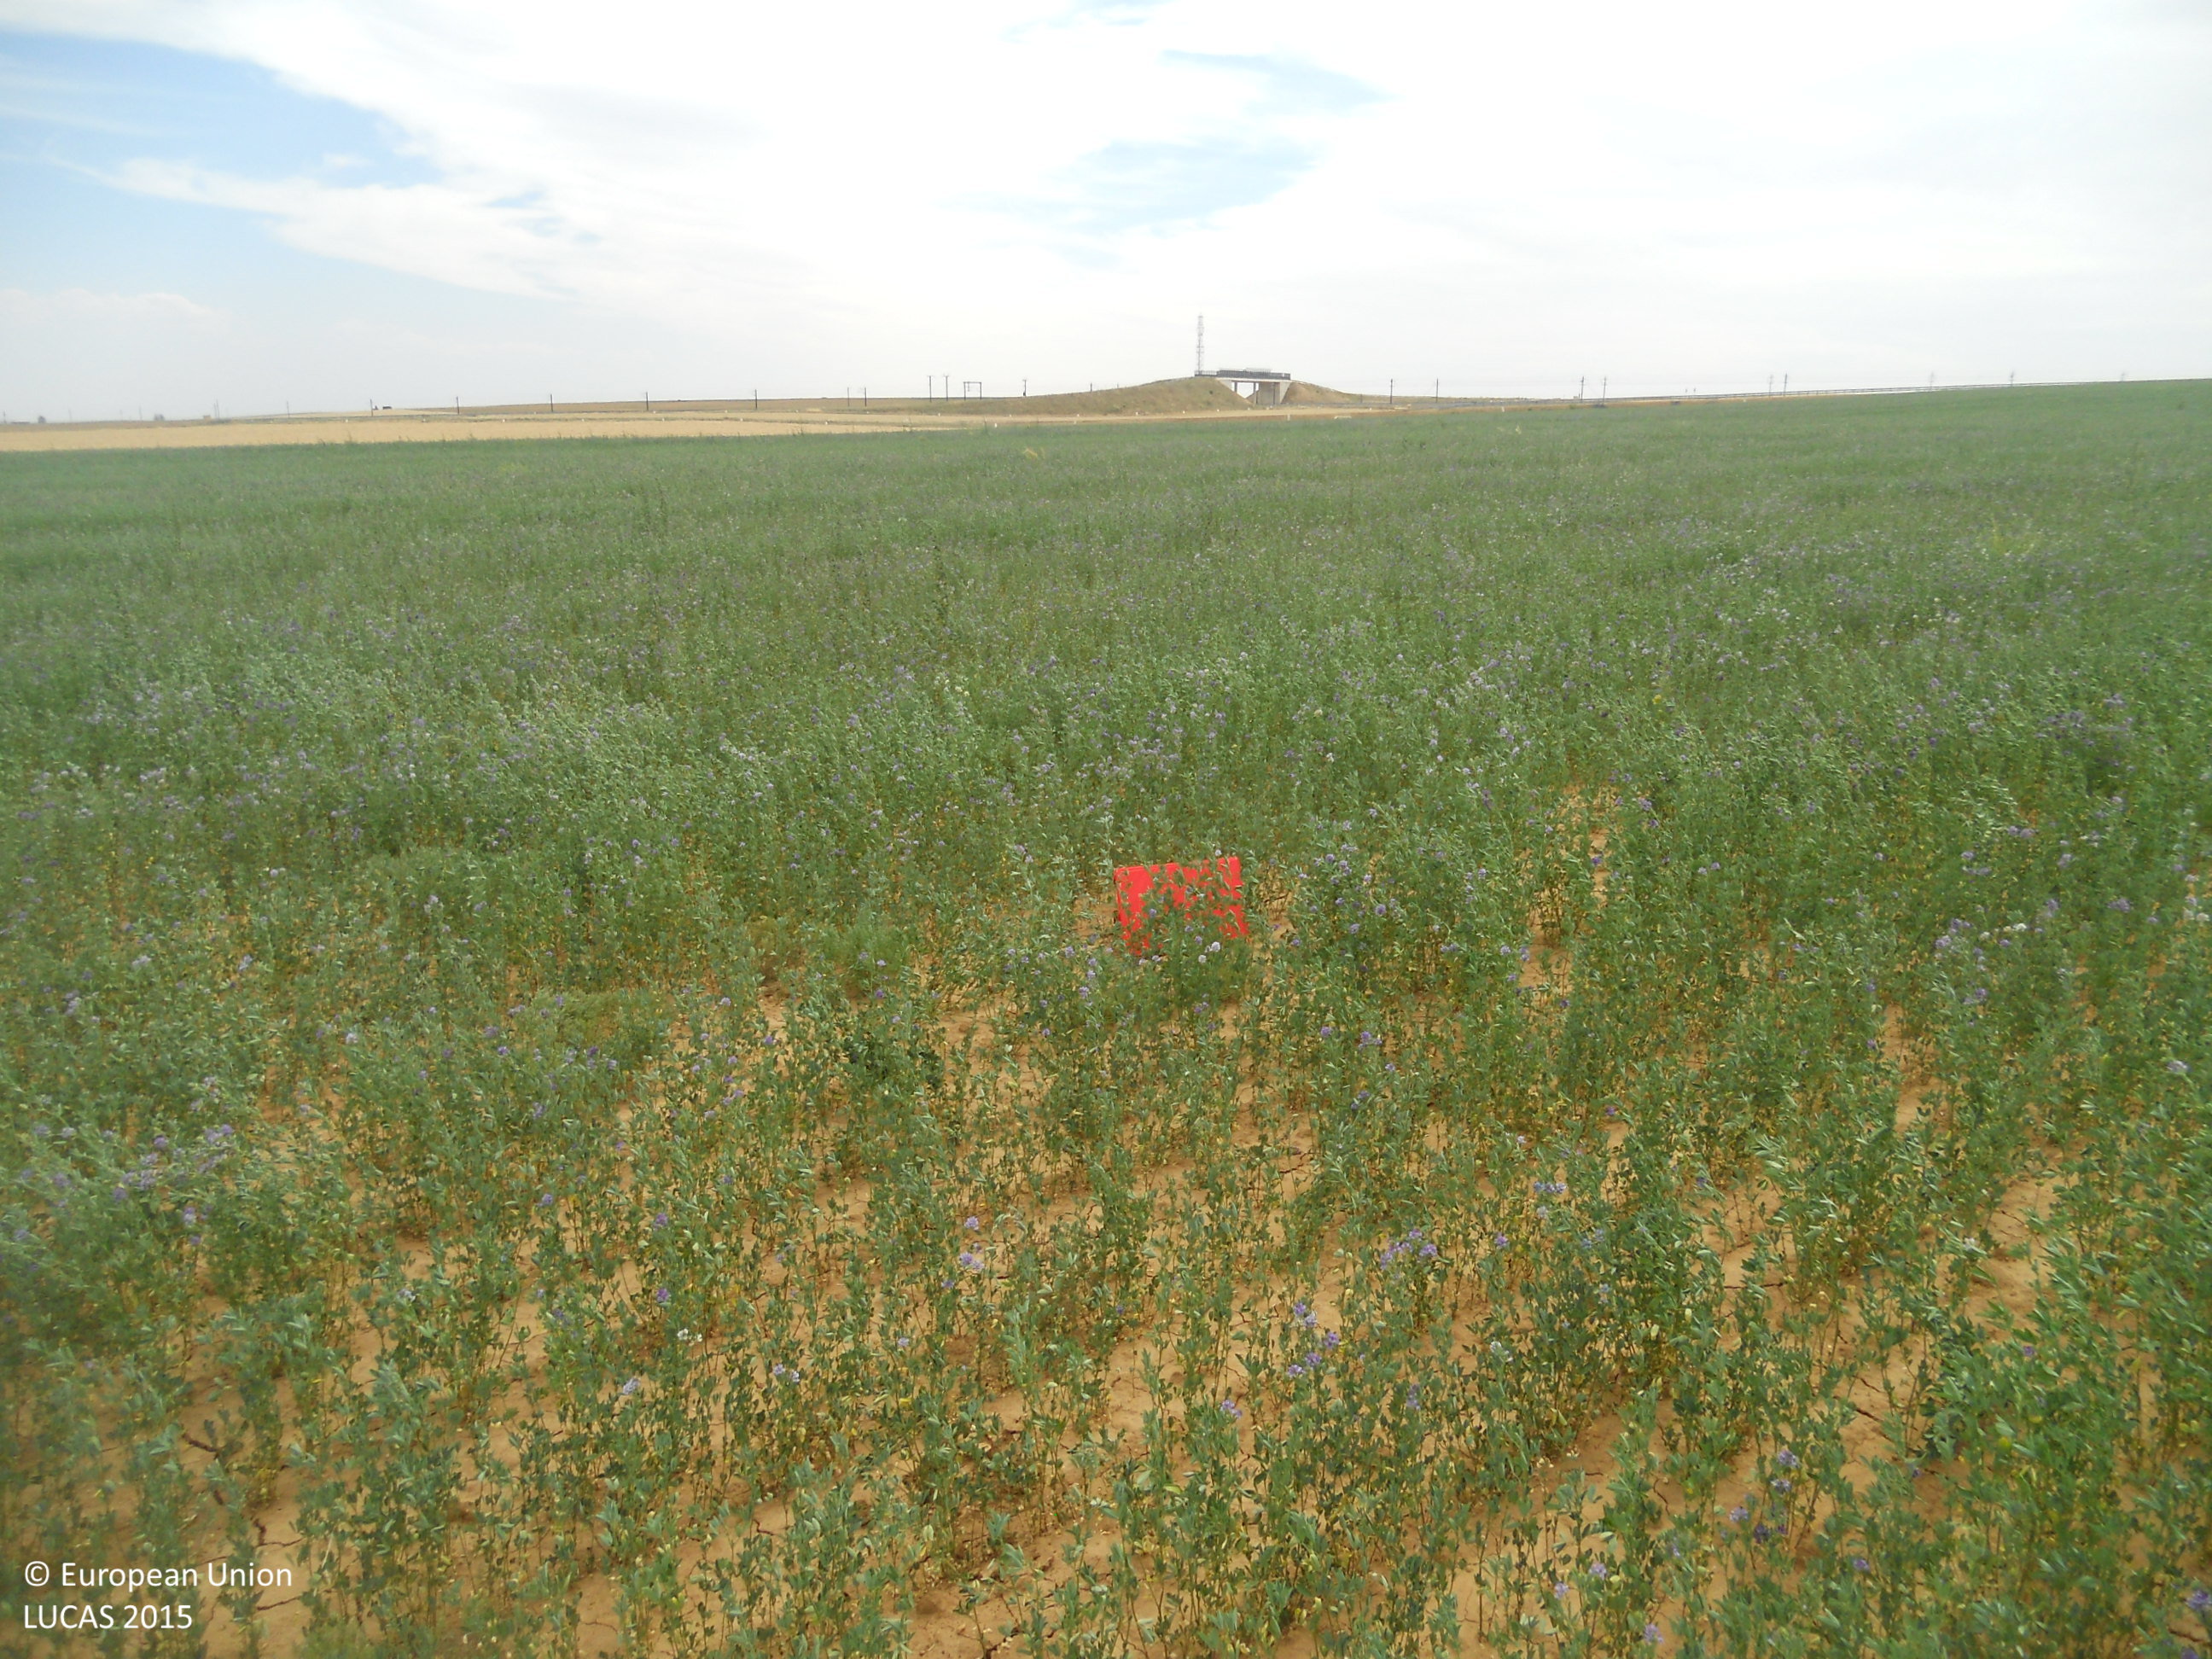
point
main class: Cropland
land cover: Lucerne
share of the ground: > 75 %
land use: Agriculture (excluding fallow land and kitchen gardens)
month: July
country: ES
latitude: 42.2025
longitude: -4.7923
